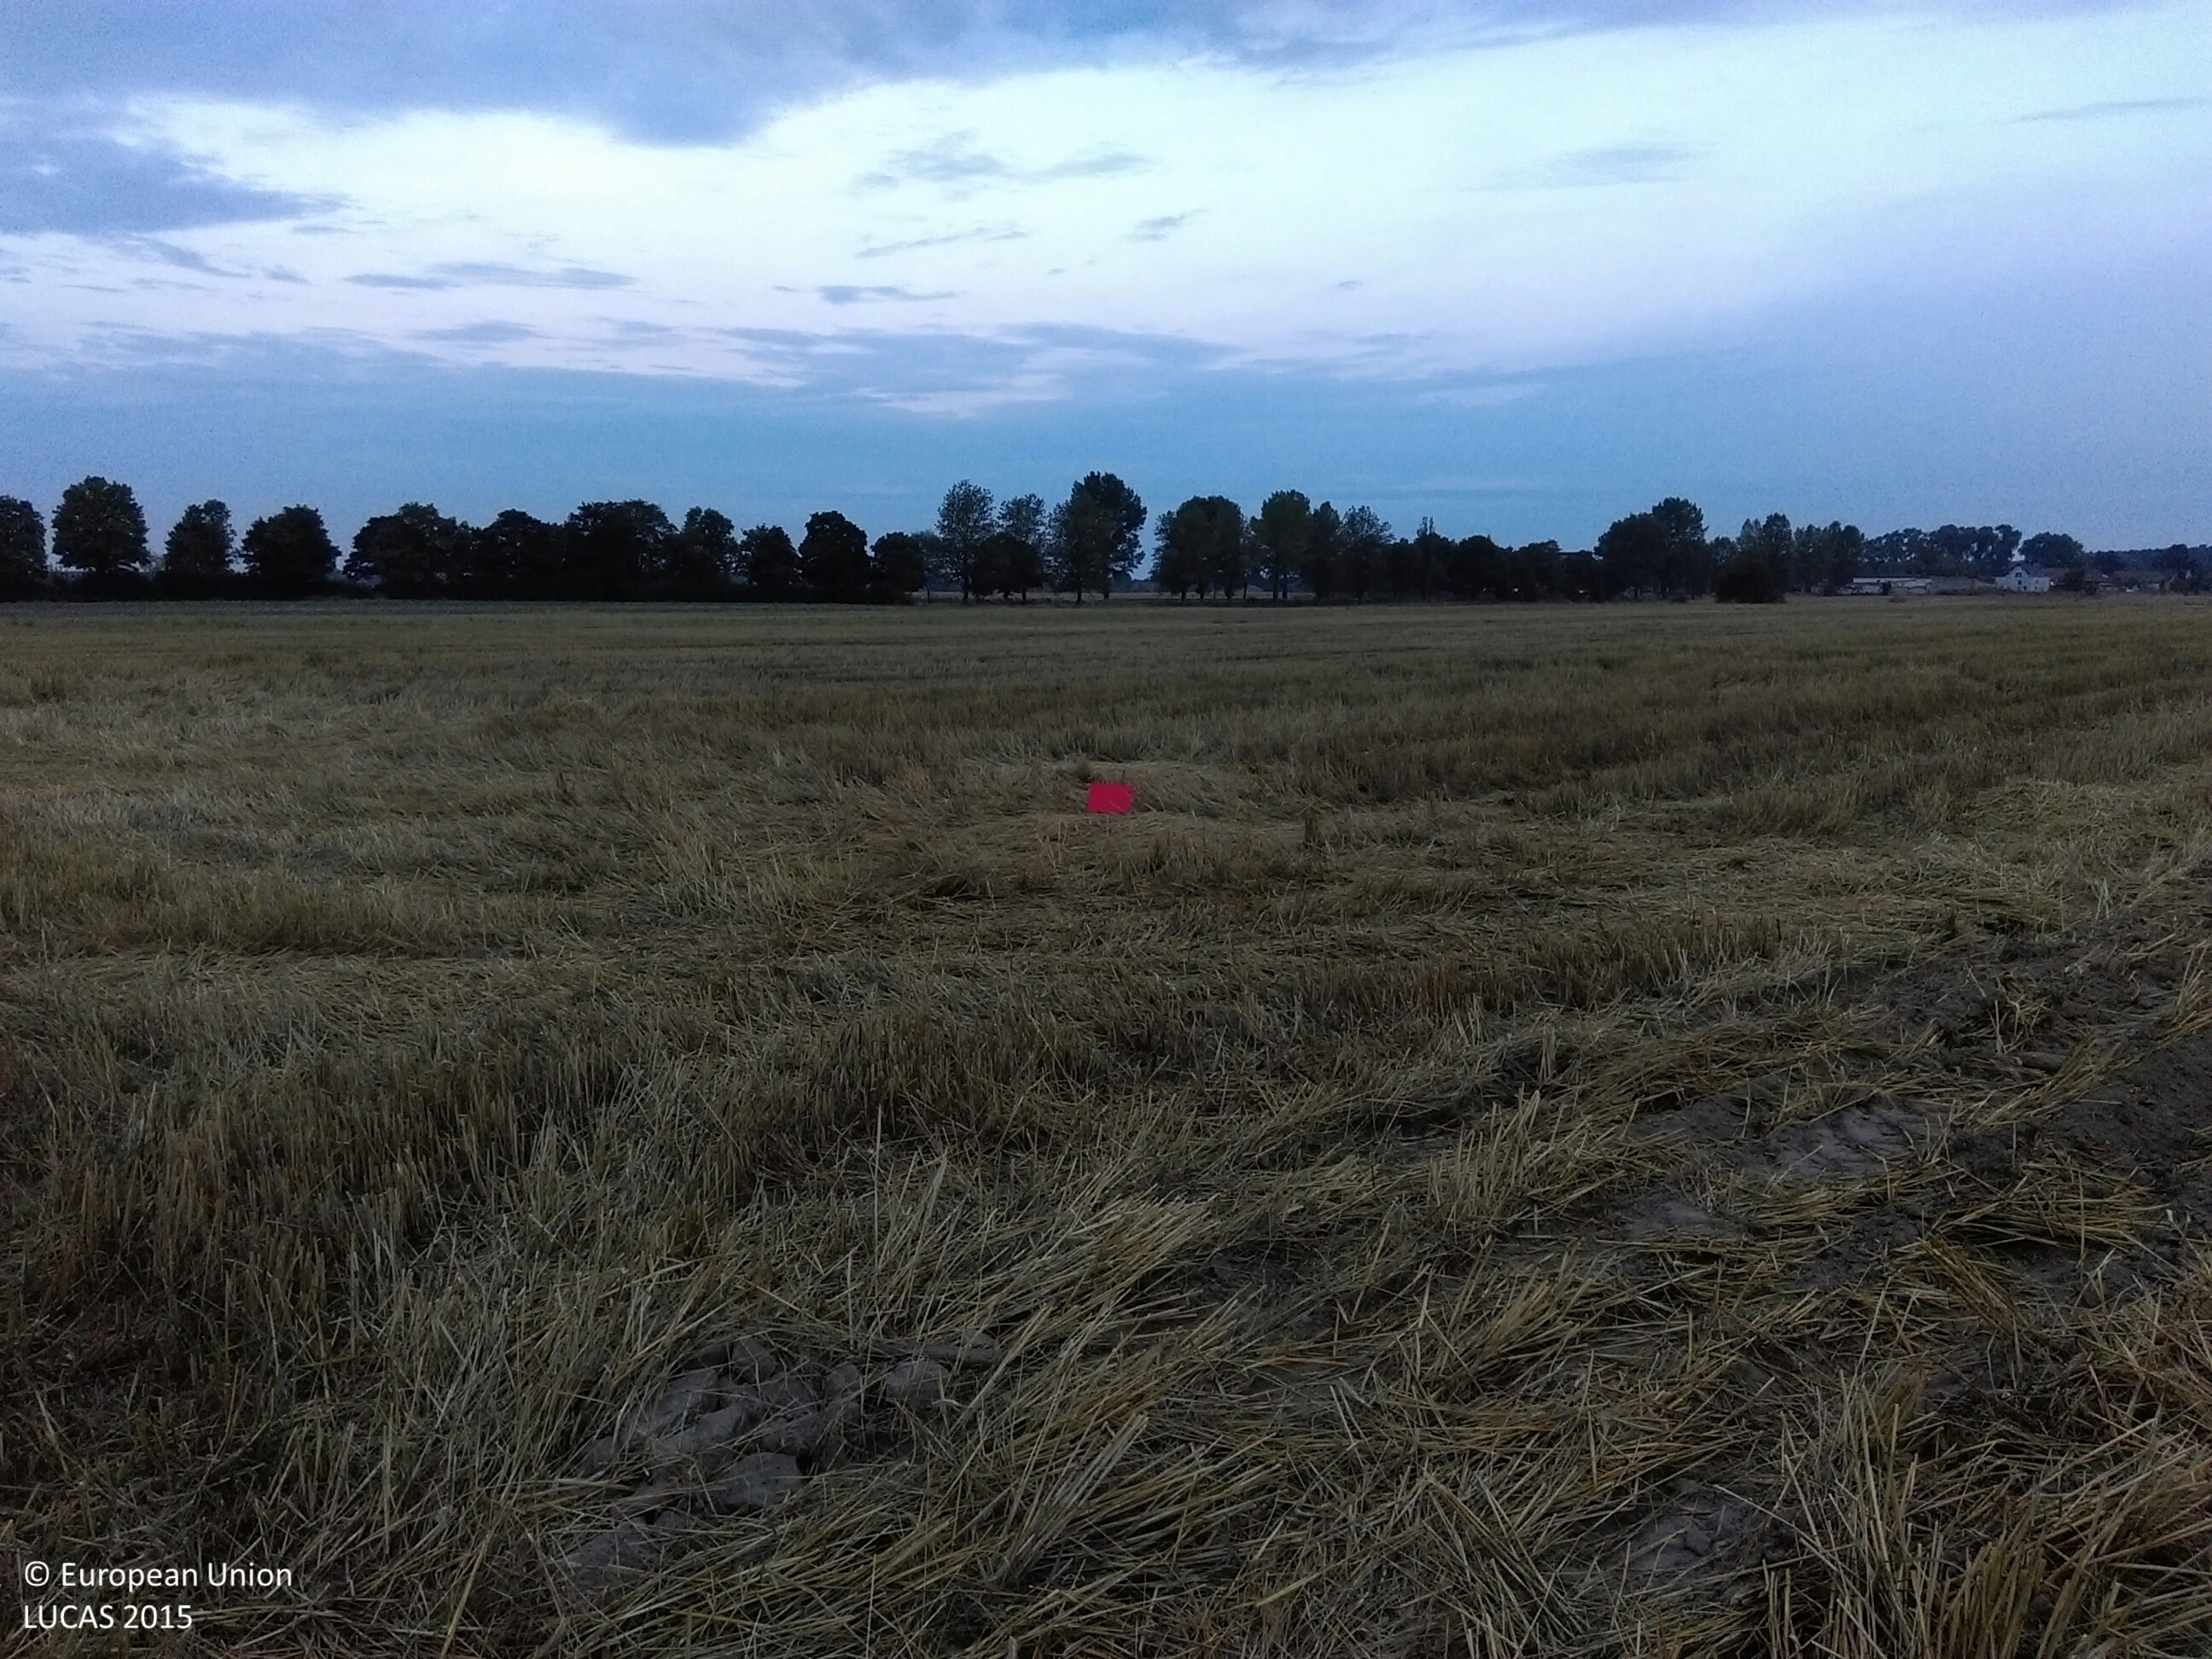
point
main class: Cropland
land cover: Rye
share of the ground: > 75 %
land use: Agriculture (excluding fallow land and kitchen gardens)
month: August
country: PL
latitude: 52.1193
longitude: 15.5980
